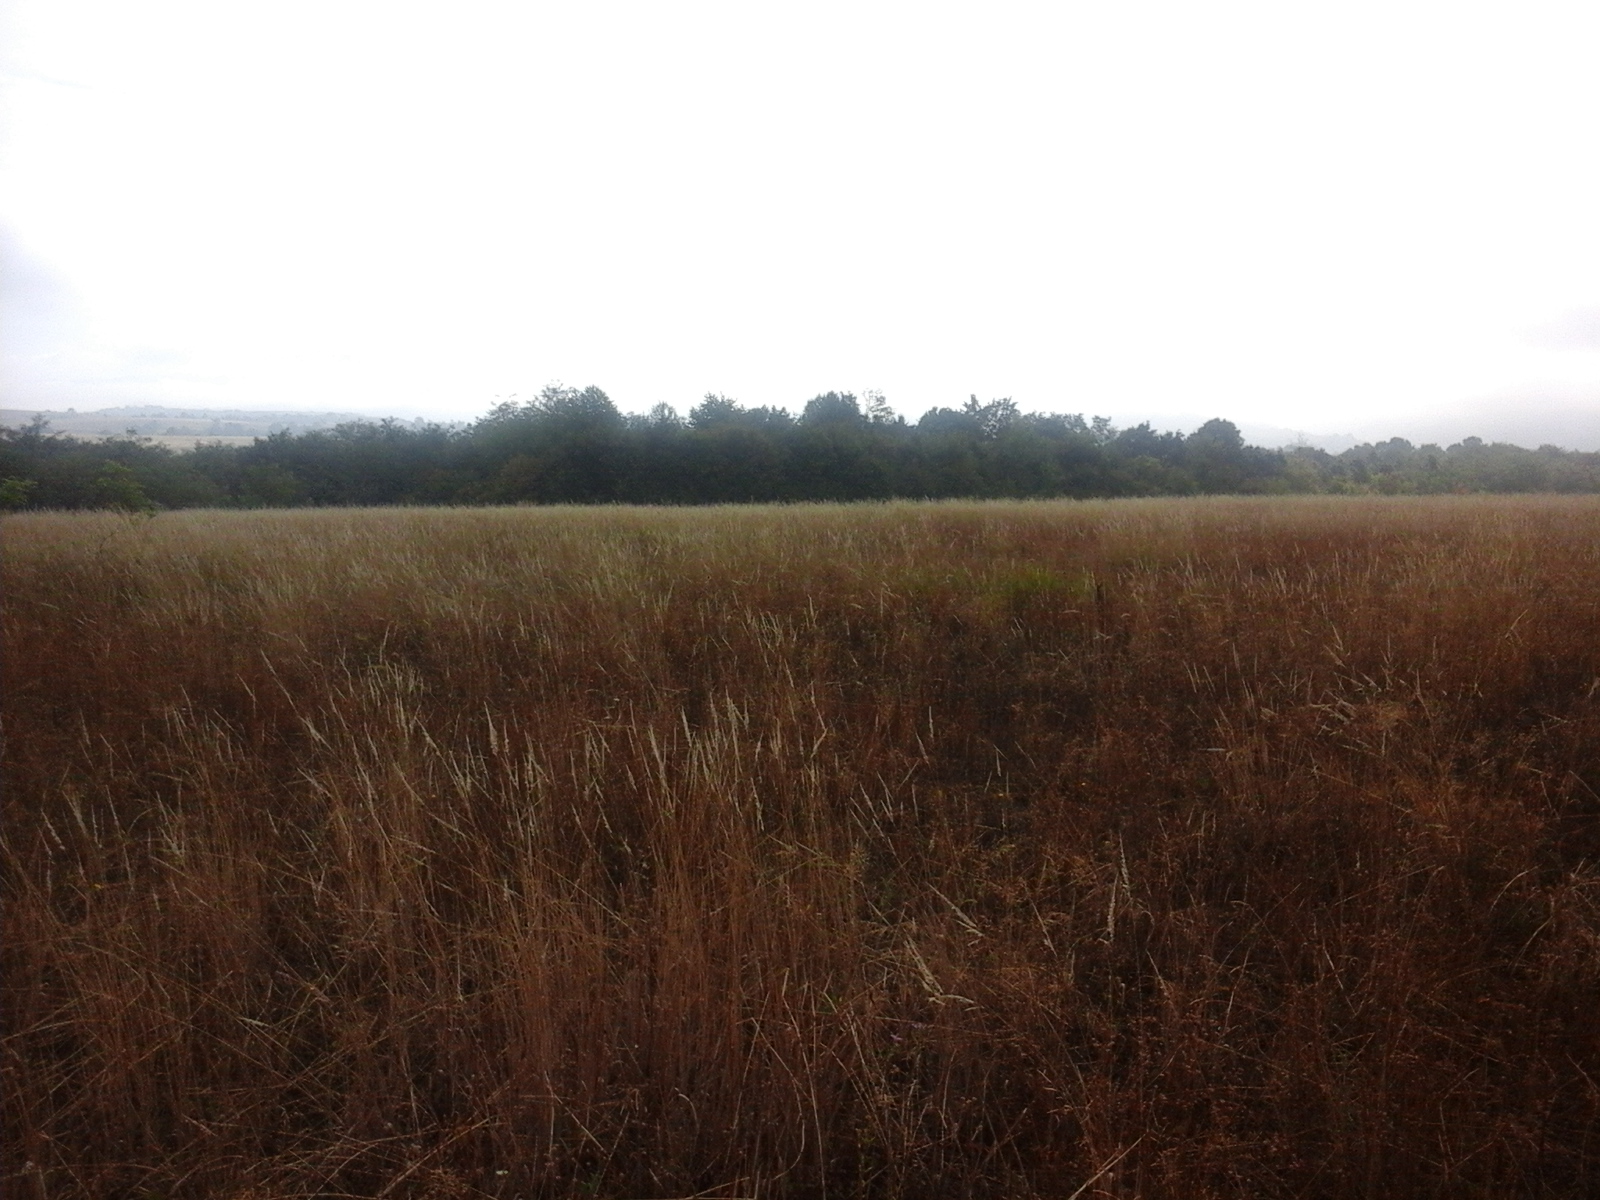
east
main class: Grassland
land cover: Grassland without tree/shrub cover
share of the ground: > 75 %
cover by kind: herbaceous plants 100 %
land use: Agriculture (excluding fallow land and kitchen gardens)
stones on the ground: < 10 %
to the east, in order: Grassland without tree/shrub cover; Broadleaved woodland
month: August
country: RO
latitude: 45.1666
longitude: 21.6479
